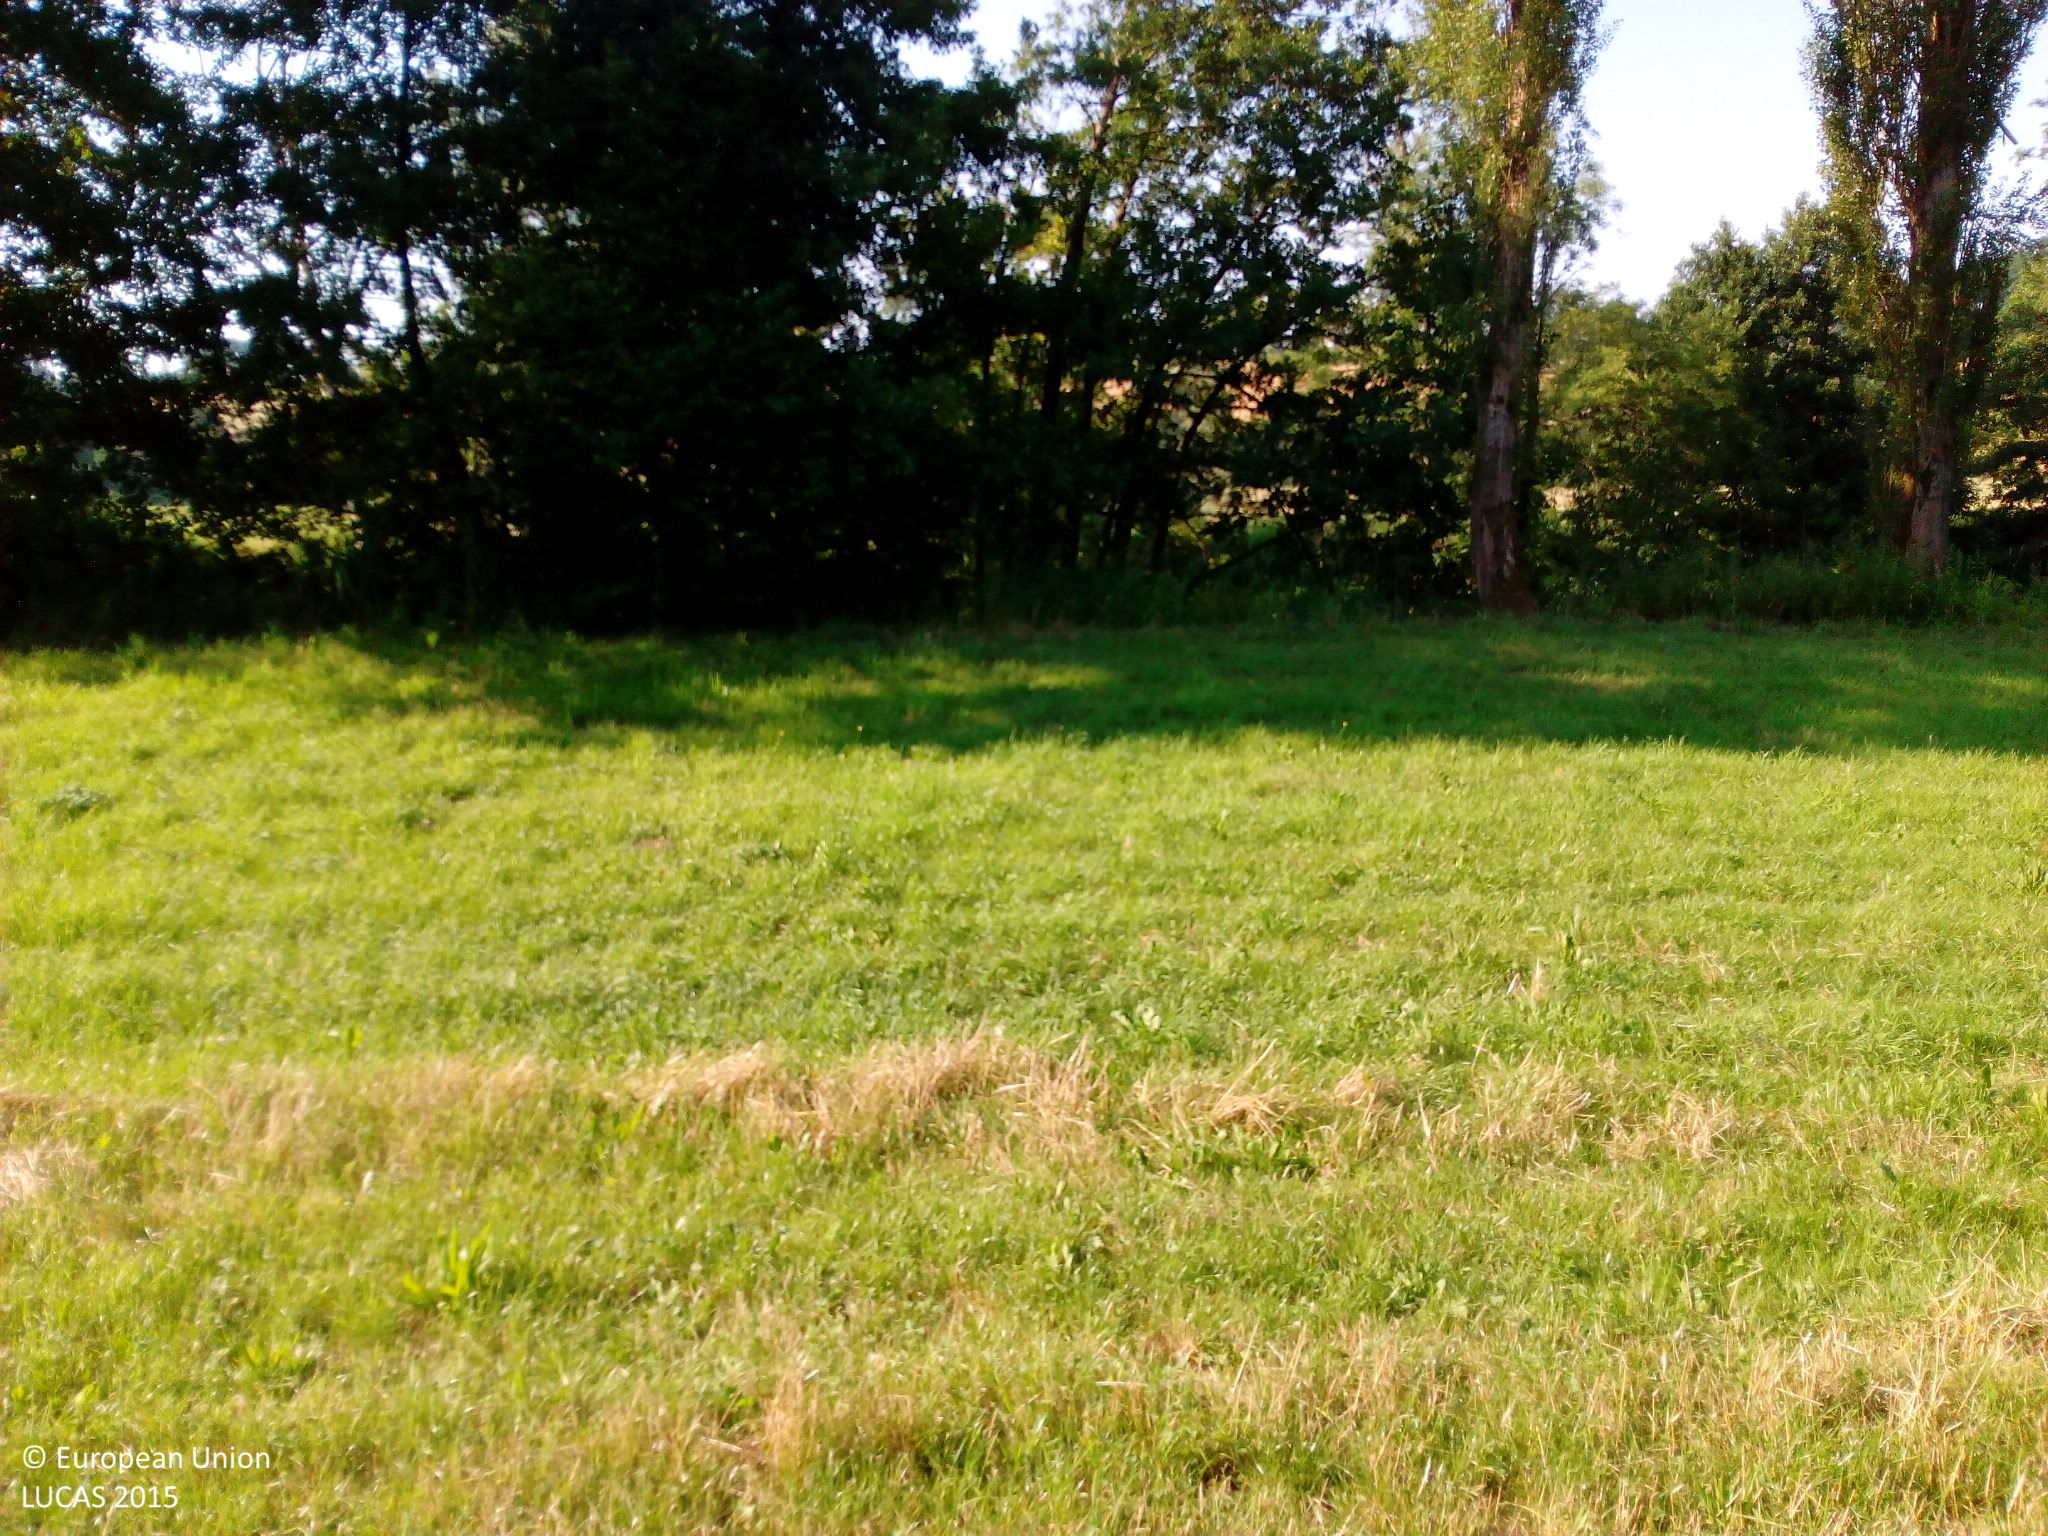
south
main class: Grassland
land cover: Grassland without tree/shrub cover
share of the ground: > 75 %
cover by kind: herbaceous plants 100 %
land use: Agriculture (excluding fallow land and kitchen gardens)
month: July
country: DE
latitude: 49.1398
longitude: 7.1082
